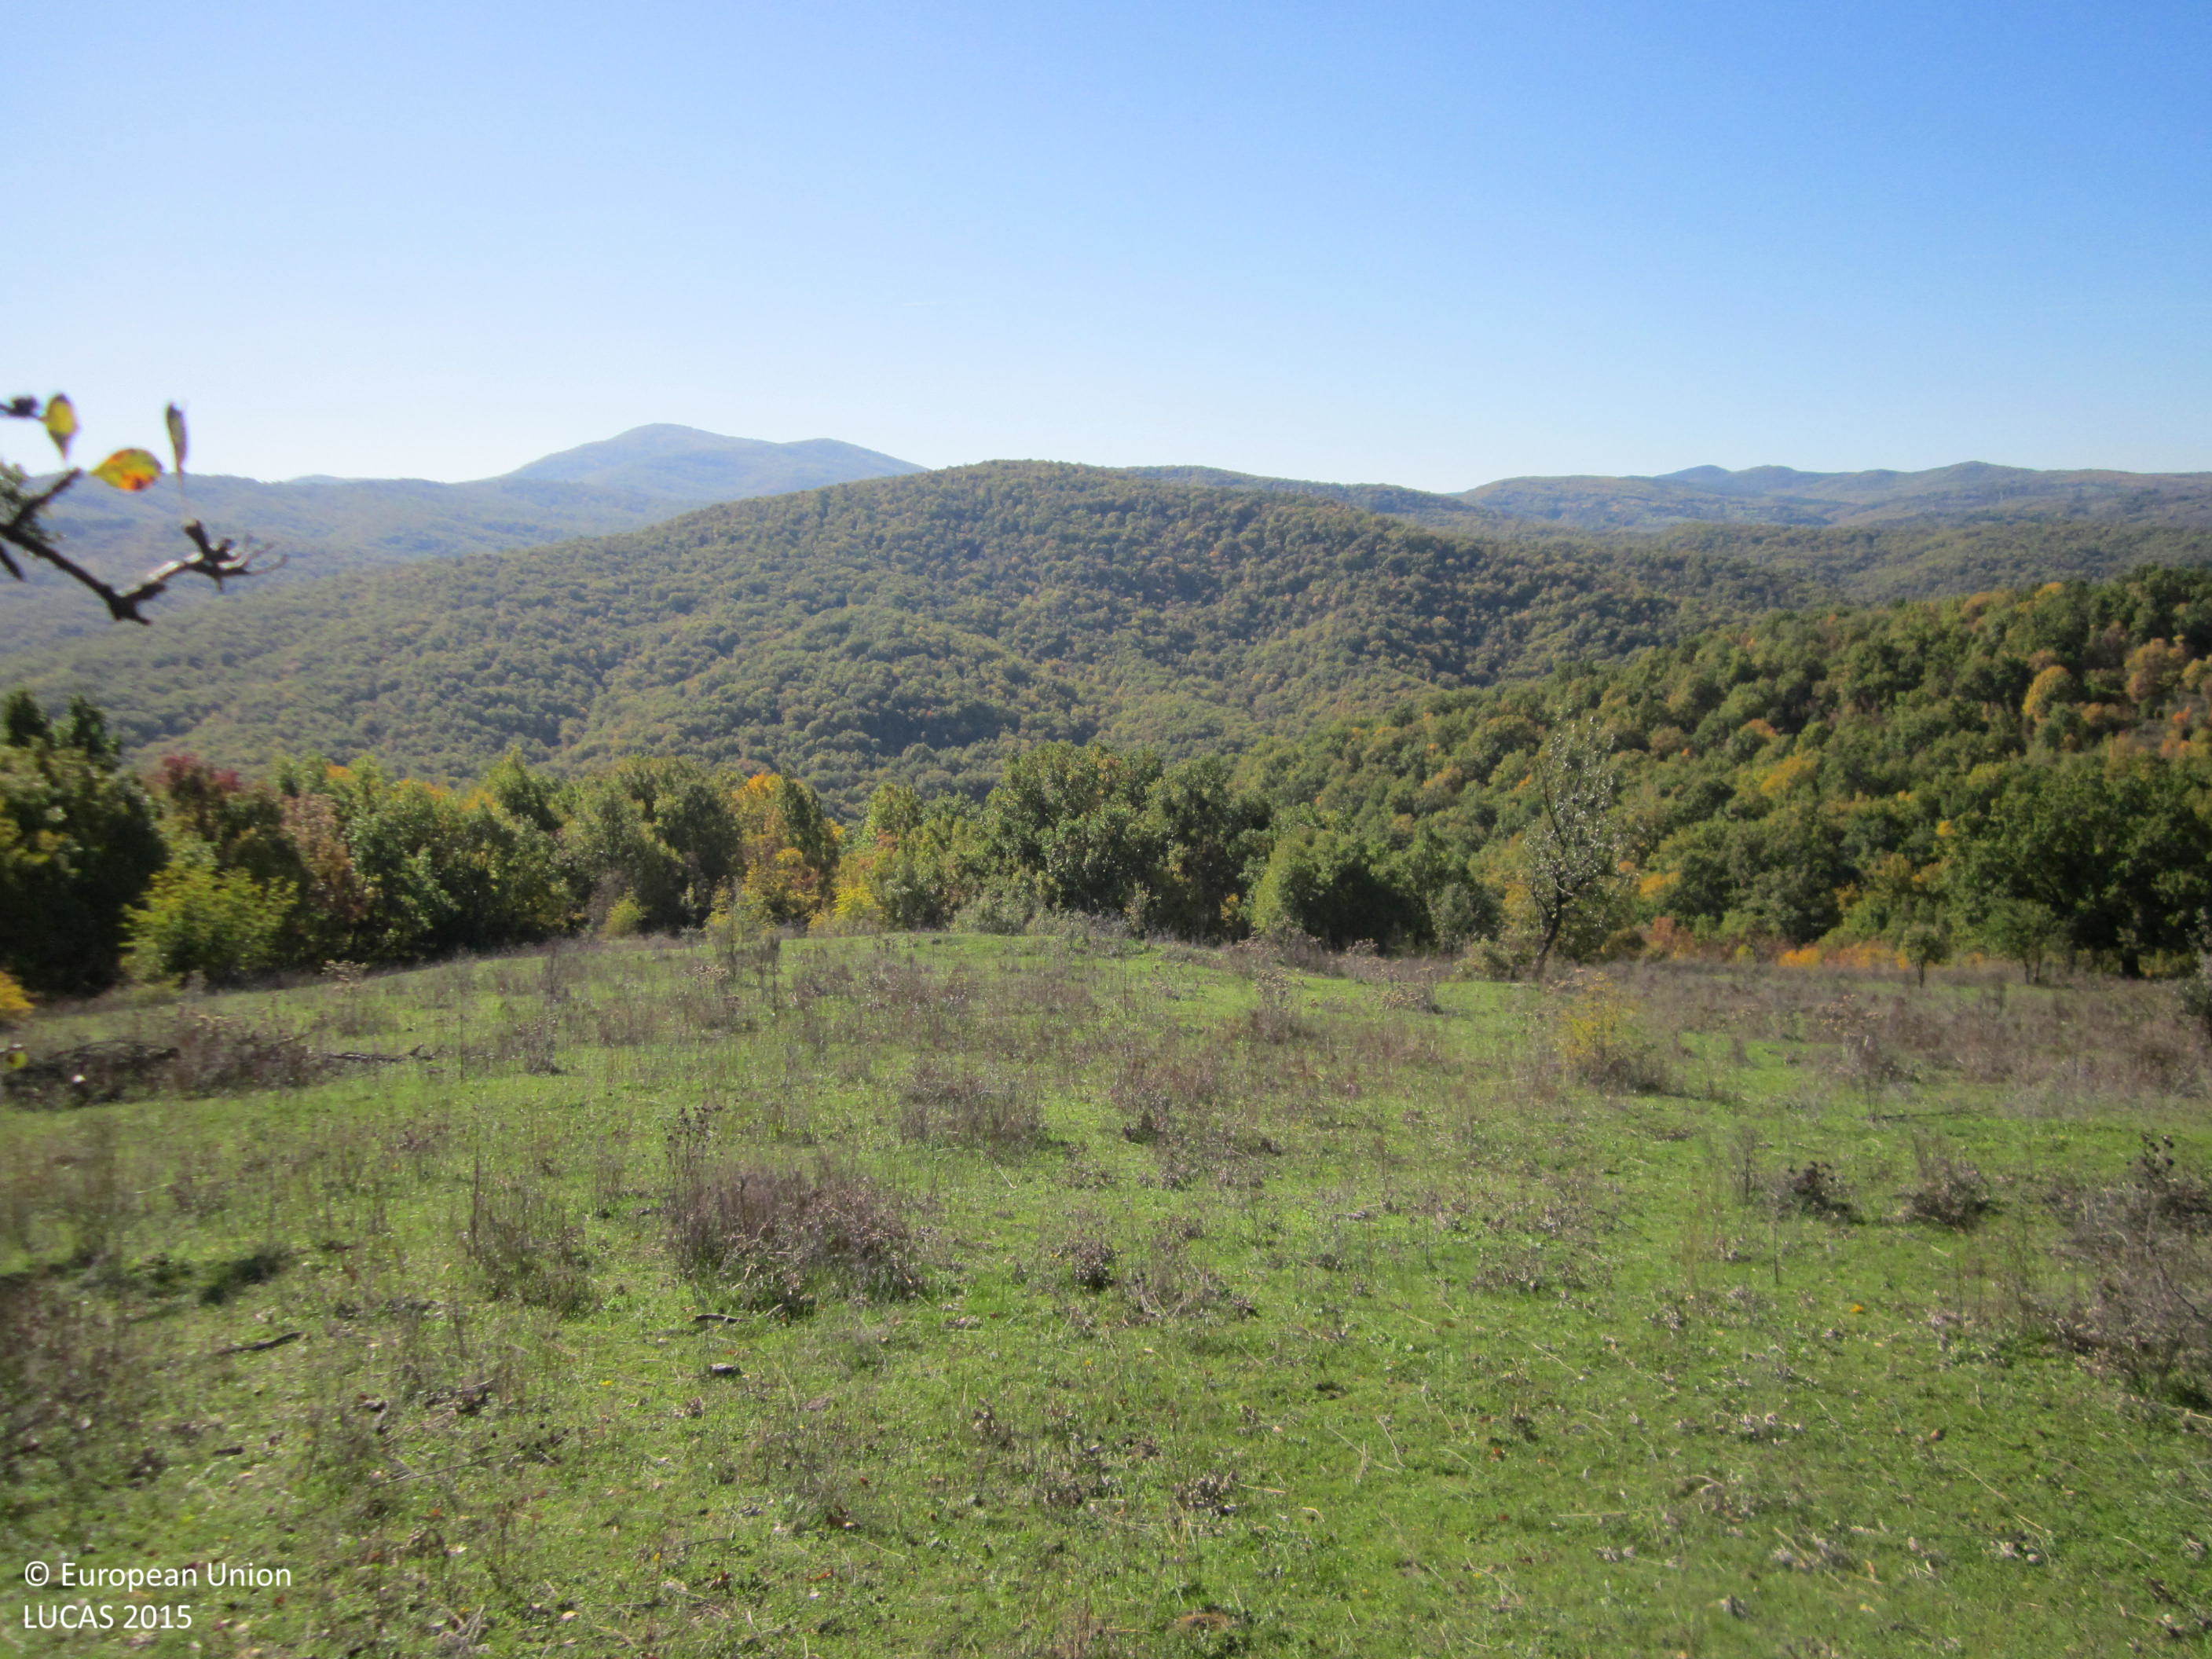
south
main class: Woodland
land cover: Broadleaved woodland
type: hemiboreal forest and nemoral coniferous forest and mixed broadleaved-coniferous forest
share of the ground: > 75 %
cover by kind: broadleaved forest trees 100 %
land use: Forestry
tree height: > 5 m
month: November
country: BG
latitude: 41.4337
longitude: 25.8485
